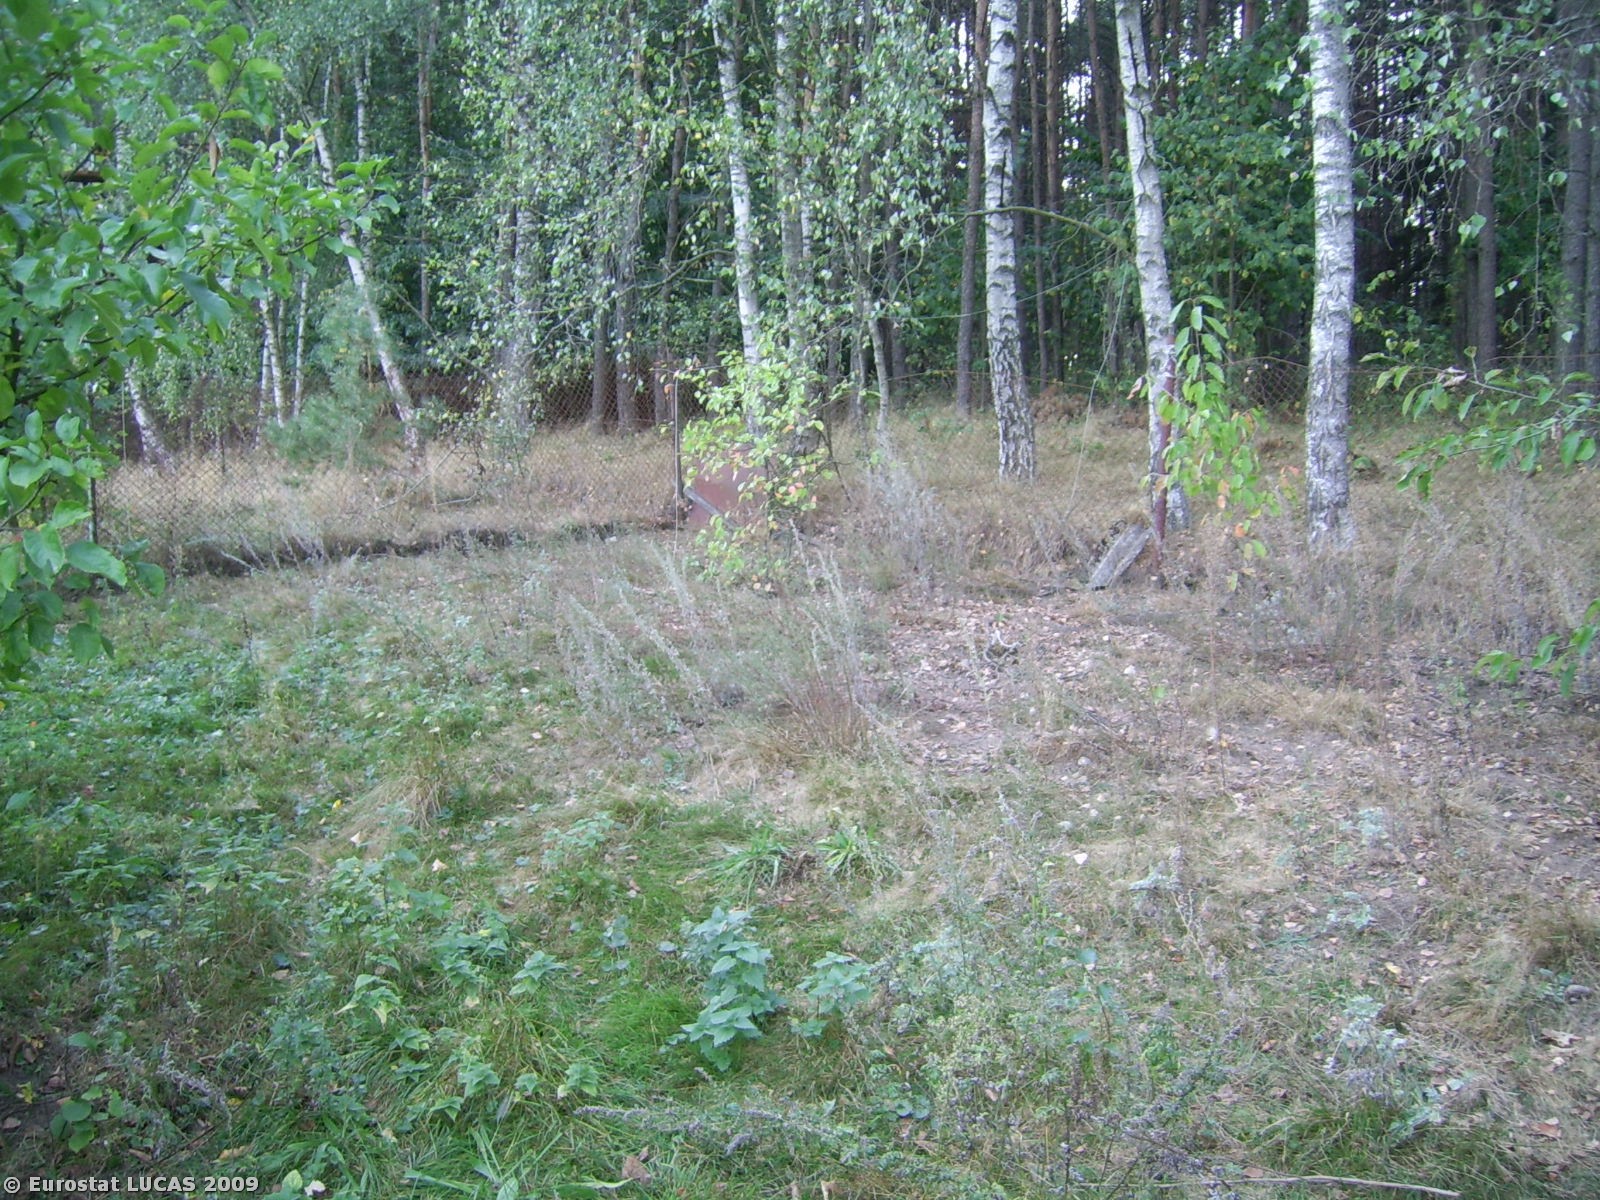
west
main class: Woodland
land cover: Broadleaved woodland
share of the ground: 50 - 75 %
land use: Residential
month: September
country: PL
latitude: 53.6324
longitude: 16.3424
